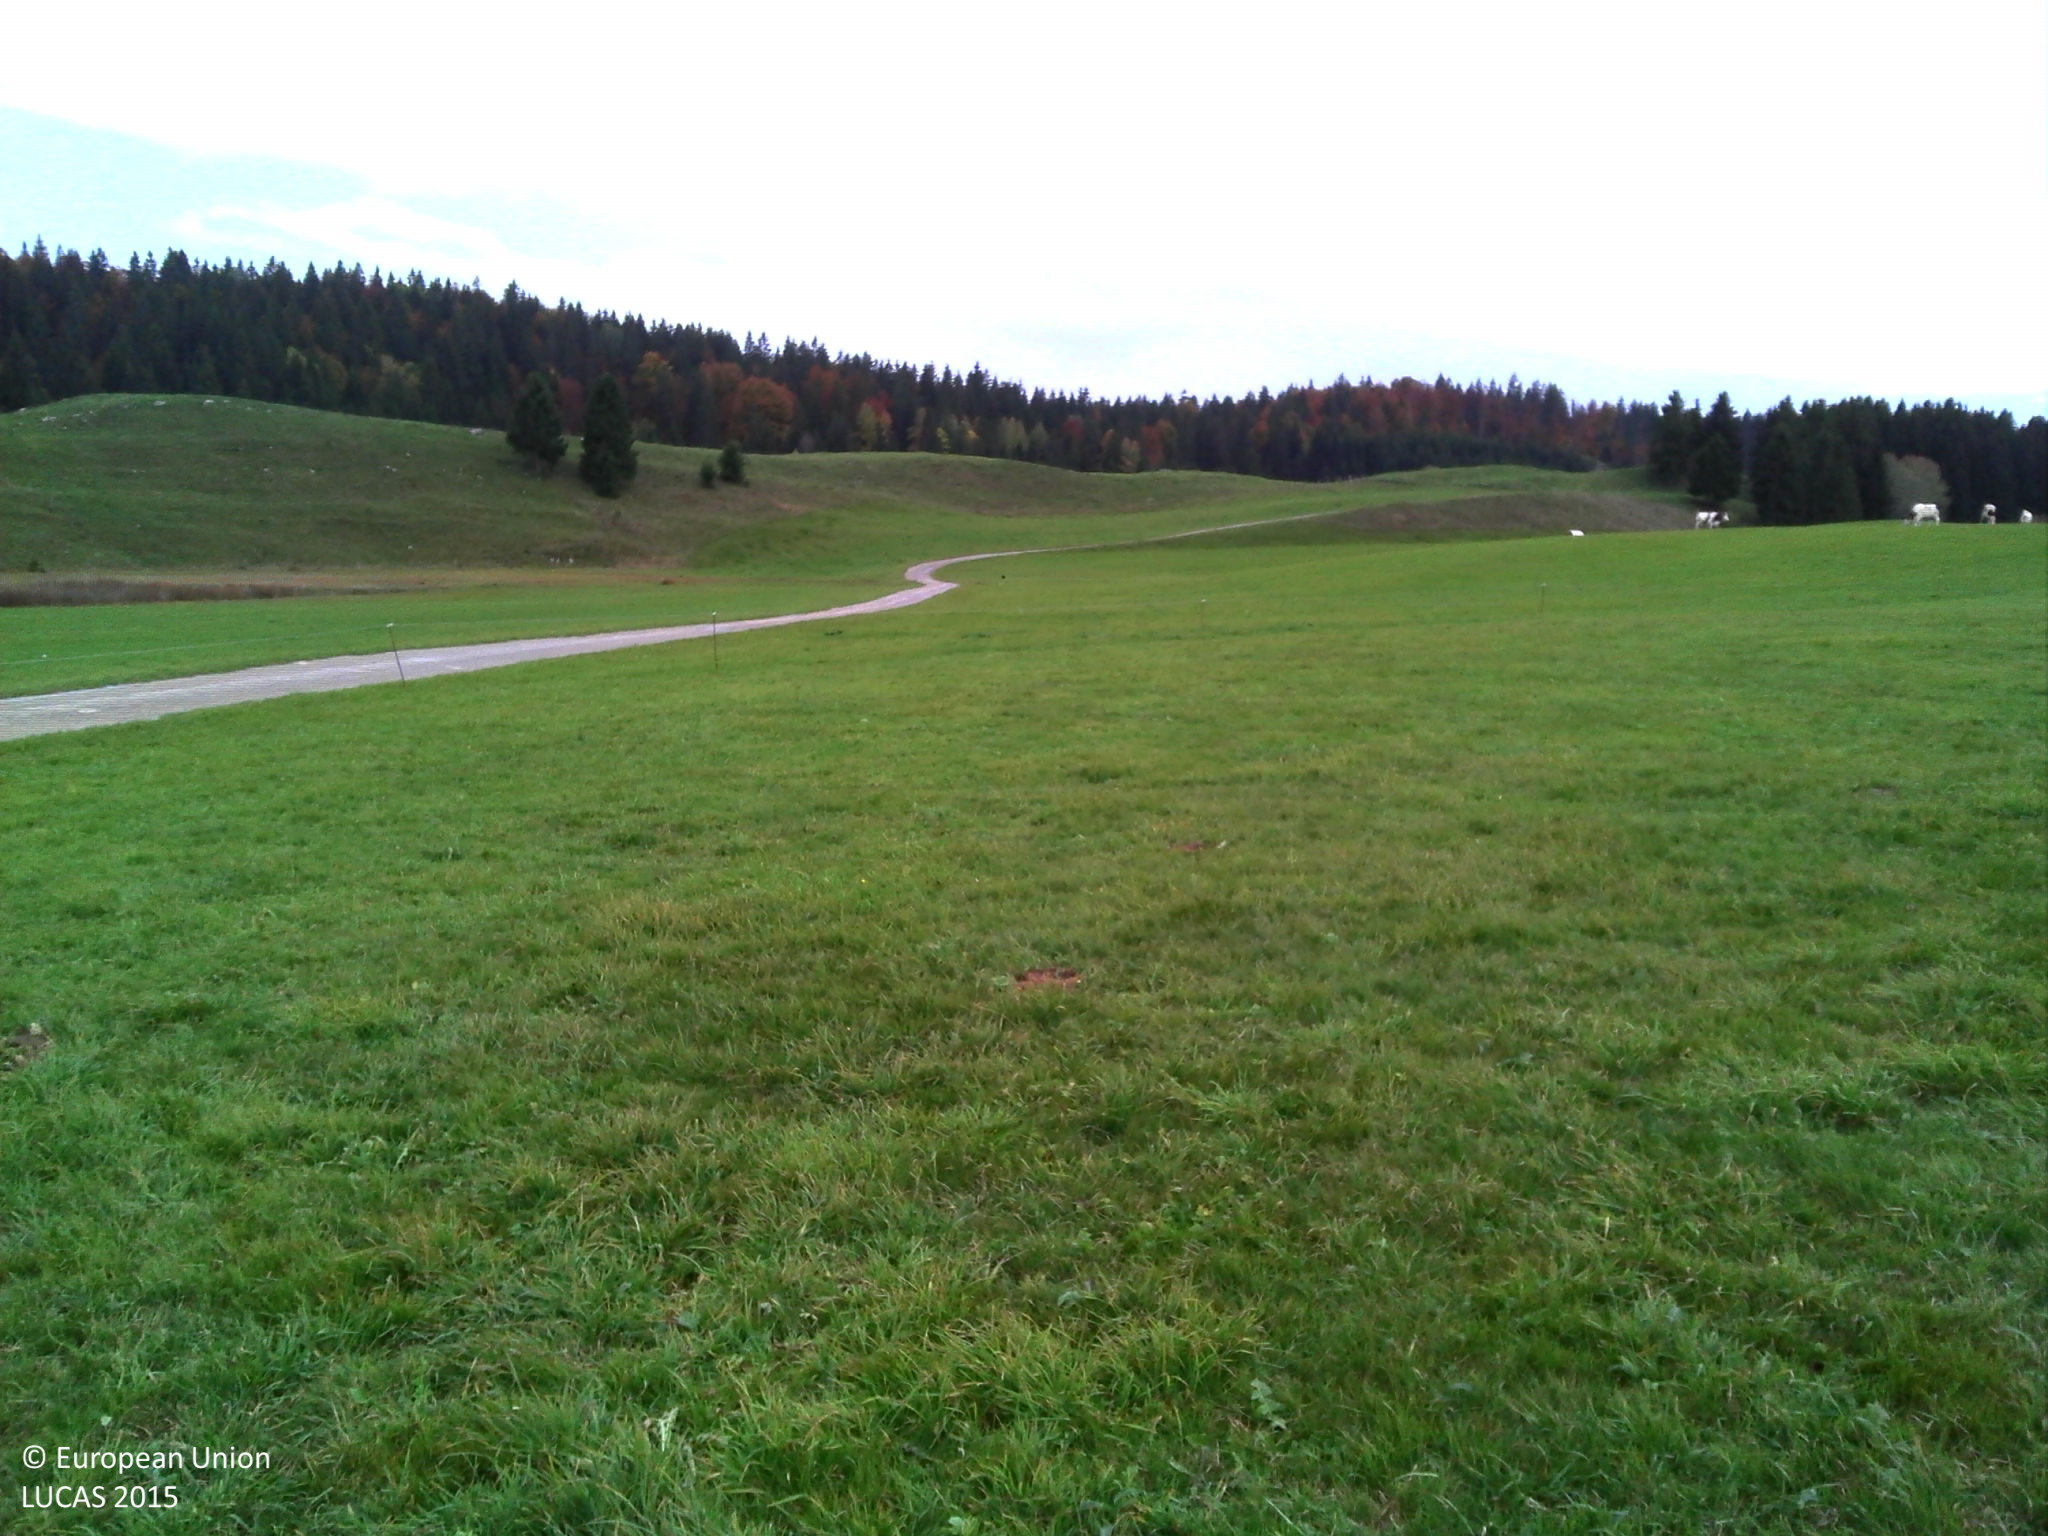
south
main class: Grassland
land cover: Grassland without tree/shrub cover
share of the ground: > 75 %
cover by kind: herbaceous plants 100 %
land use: Agriculture (excluding fallow land and kitchen gardens)
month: October
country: FR
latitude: 46.7154
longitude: 6.1696
